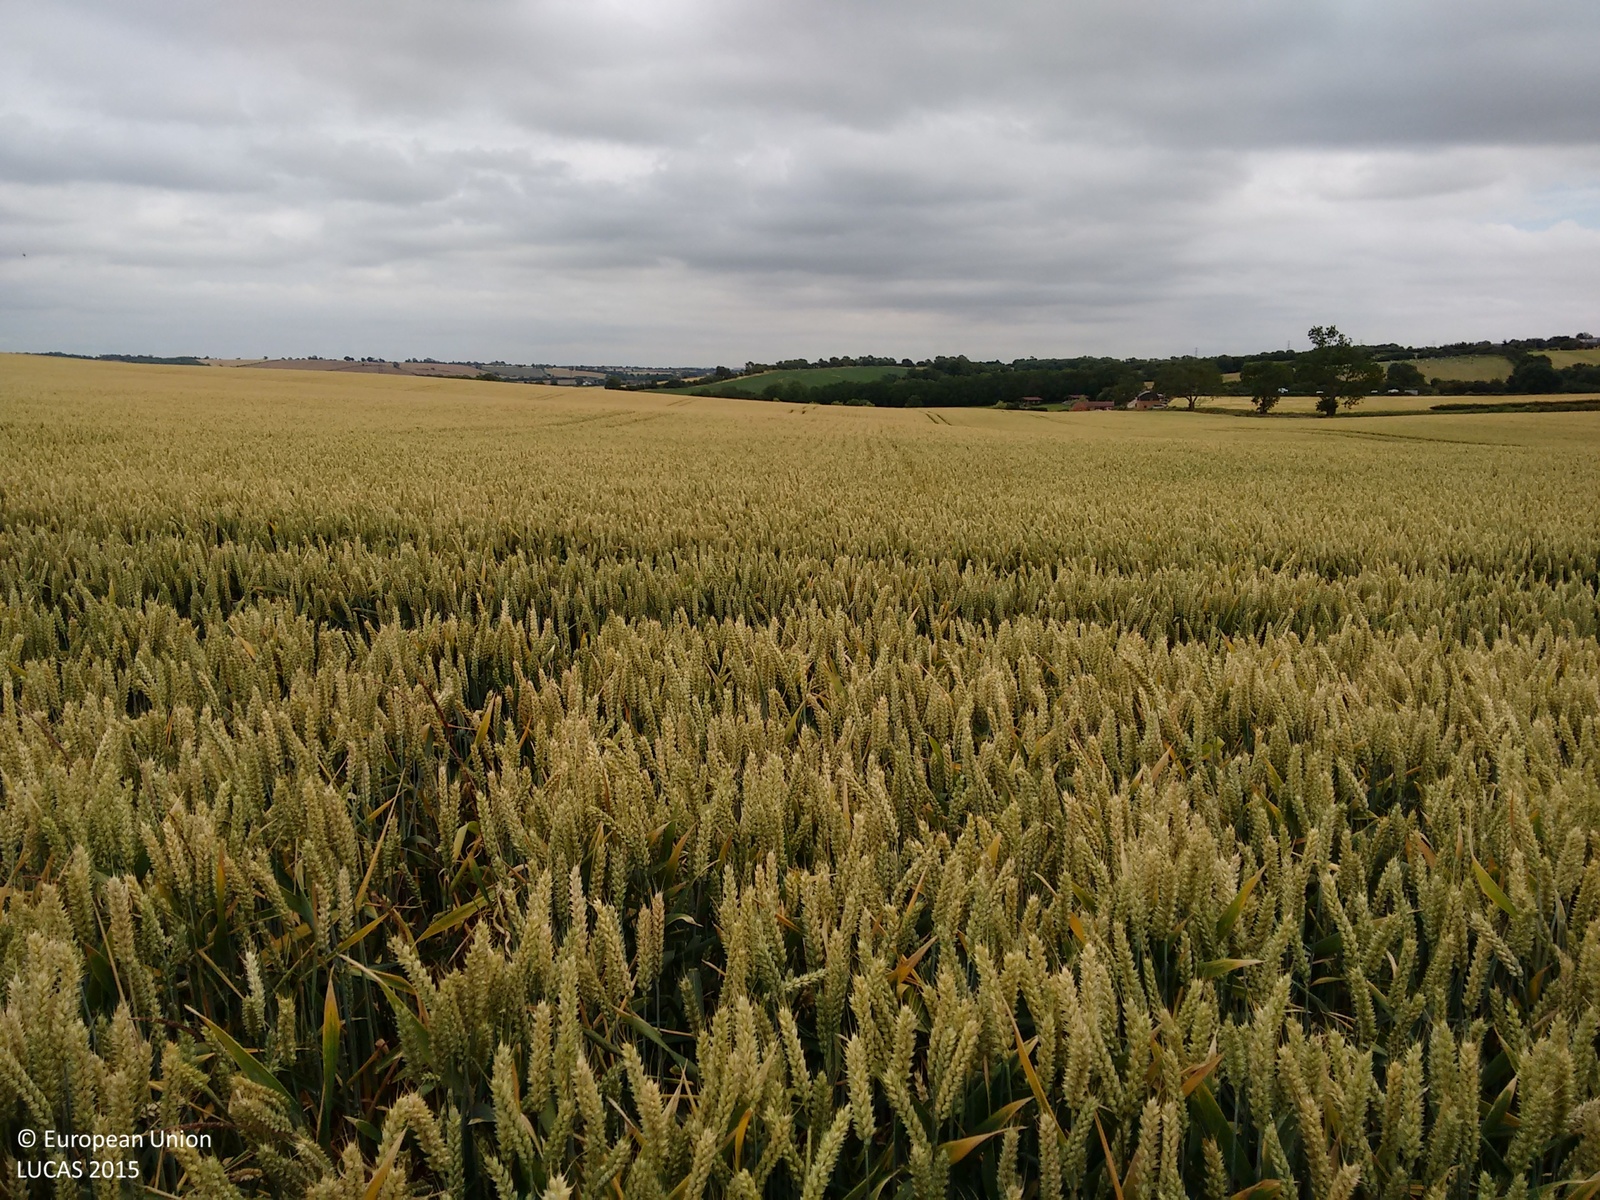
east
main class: Cropland
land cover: Common wheat
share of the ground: > 75 %
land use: Agriculture (excluding fallow land and kitchen gardens)
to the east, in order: Common wheat
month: July
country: GB
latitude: 52.4530
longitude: -0.9176
